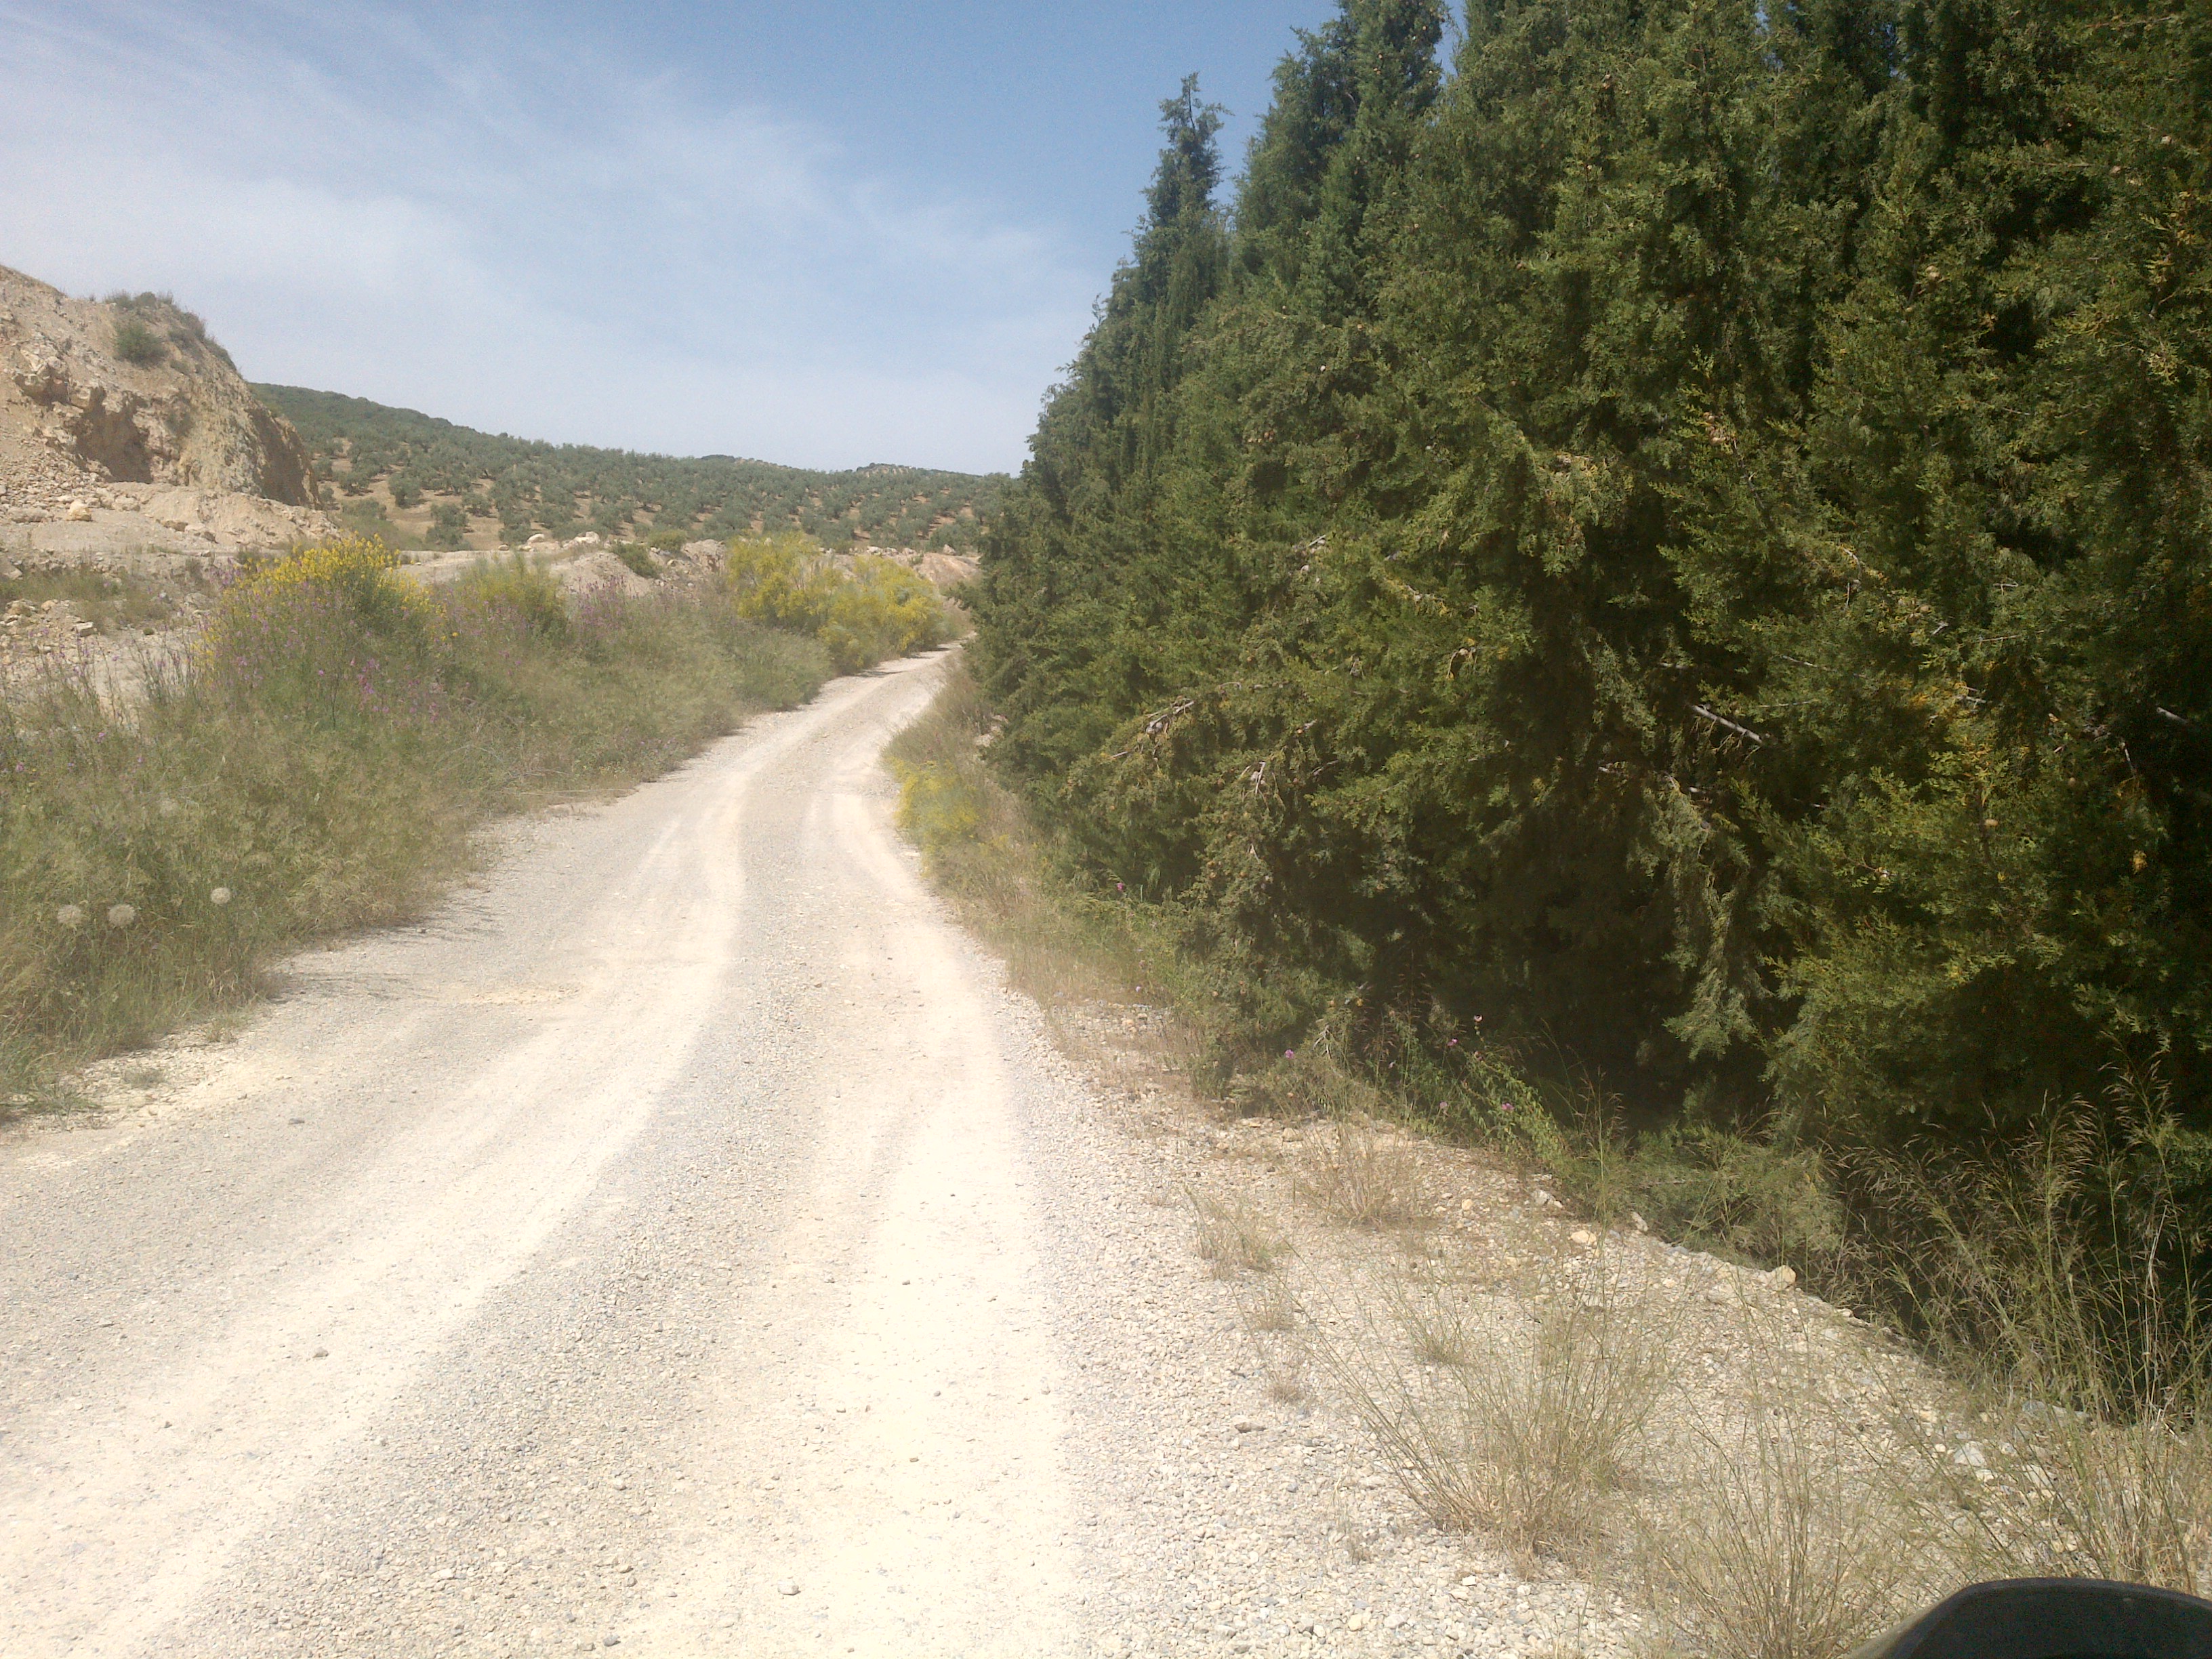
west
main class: Shrubland
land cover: Shrubland without tree cover
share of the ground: 25 - 50 %
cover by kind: herbaceous plants 70 %, shrubs 25 %, unconsolidated bare surface 5 %
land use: Semi-natural and natural areas not in use
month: May
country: ES
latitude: 37.4111
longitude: -4.2011
